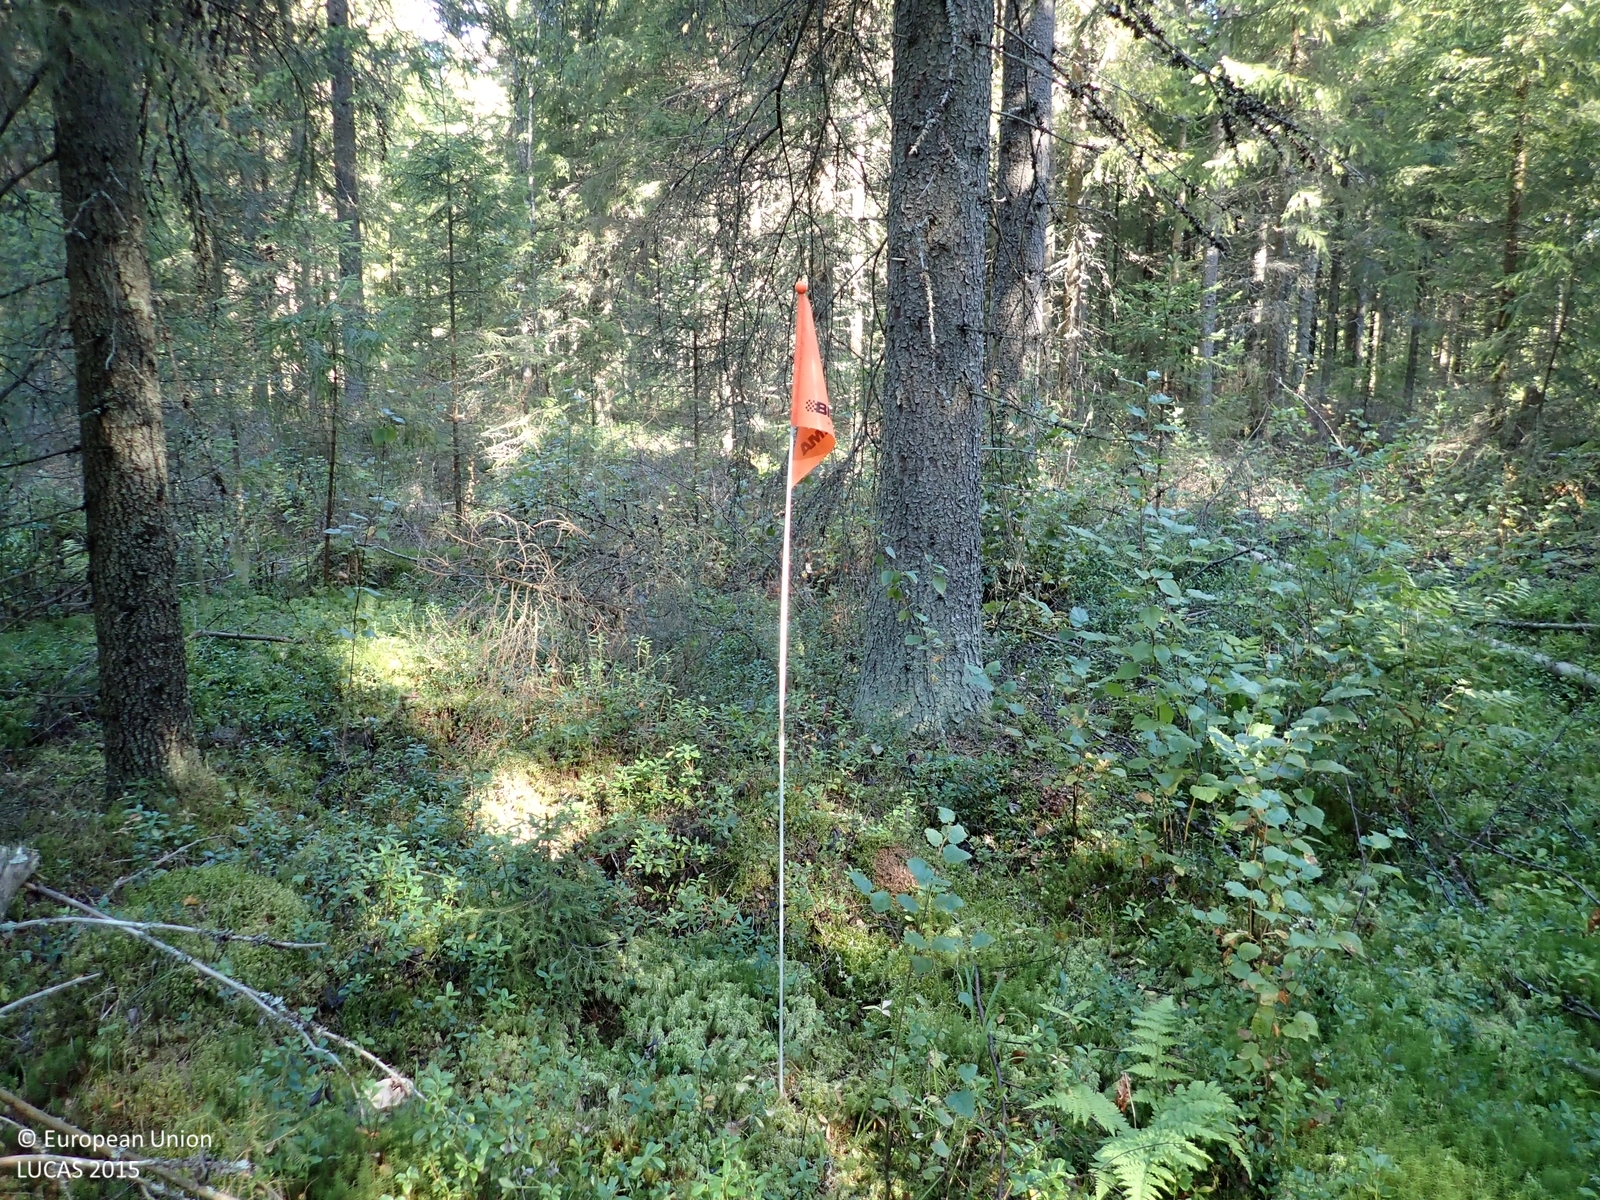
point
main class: Woodland
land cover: Spruce dominated mixed woodland
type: boreal forest
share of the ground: > 75 %
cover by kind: coniferous forest trees 55 %, broadleaved forest trees 20 %, shrubs 10 %, lichens and mosses 10 %, herbaceous plants 5 %
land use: Forestry
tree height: > 5 m
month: August
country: FI
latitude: 62.4769
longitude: 21.7823
